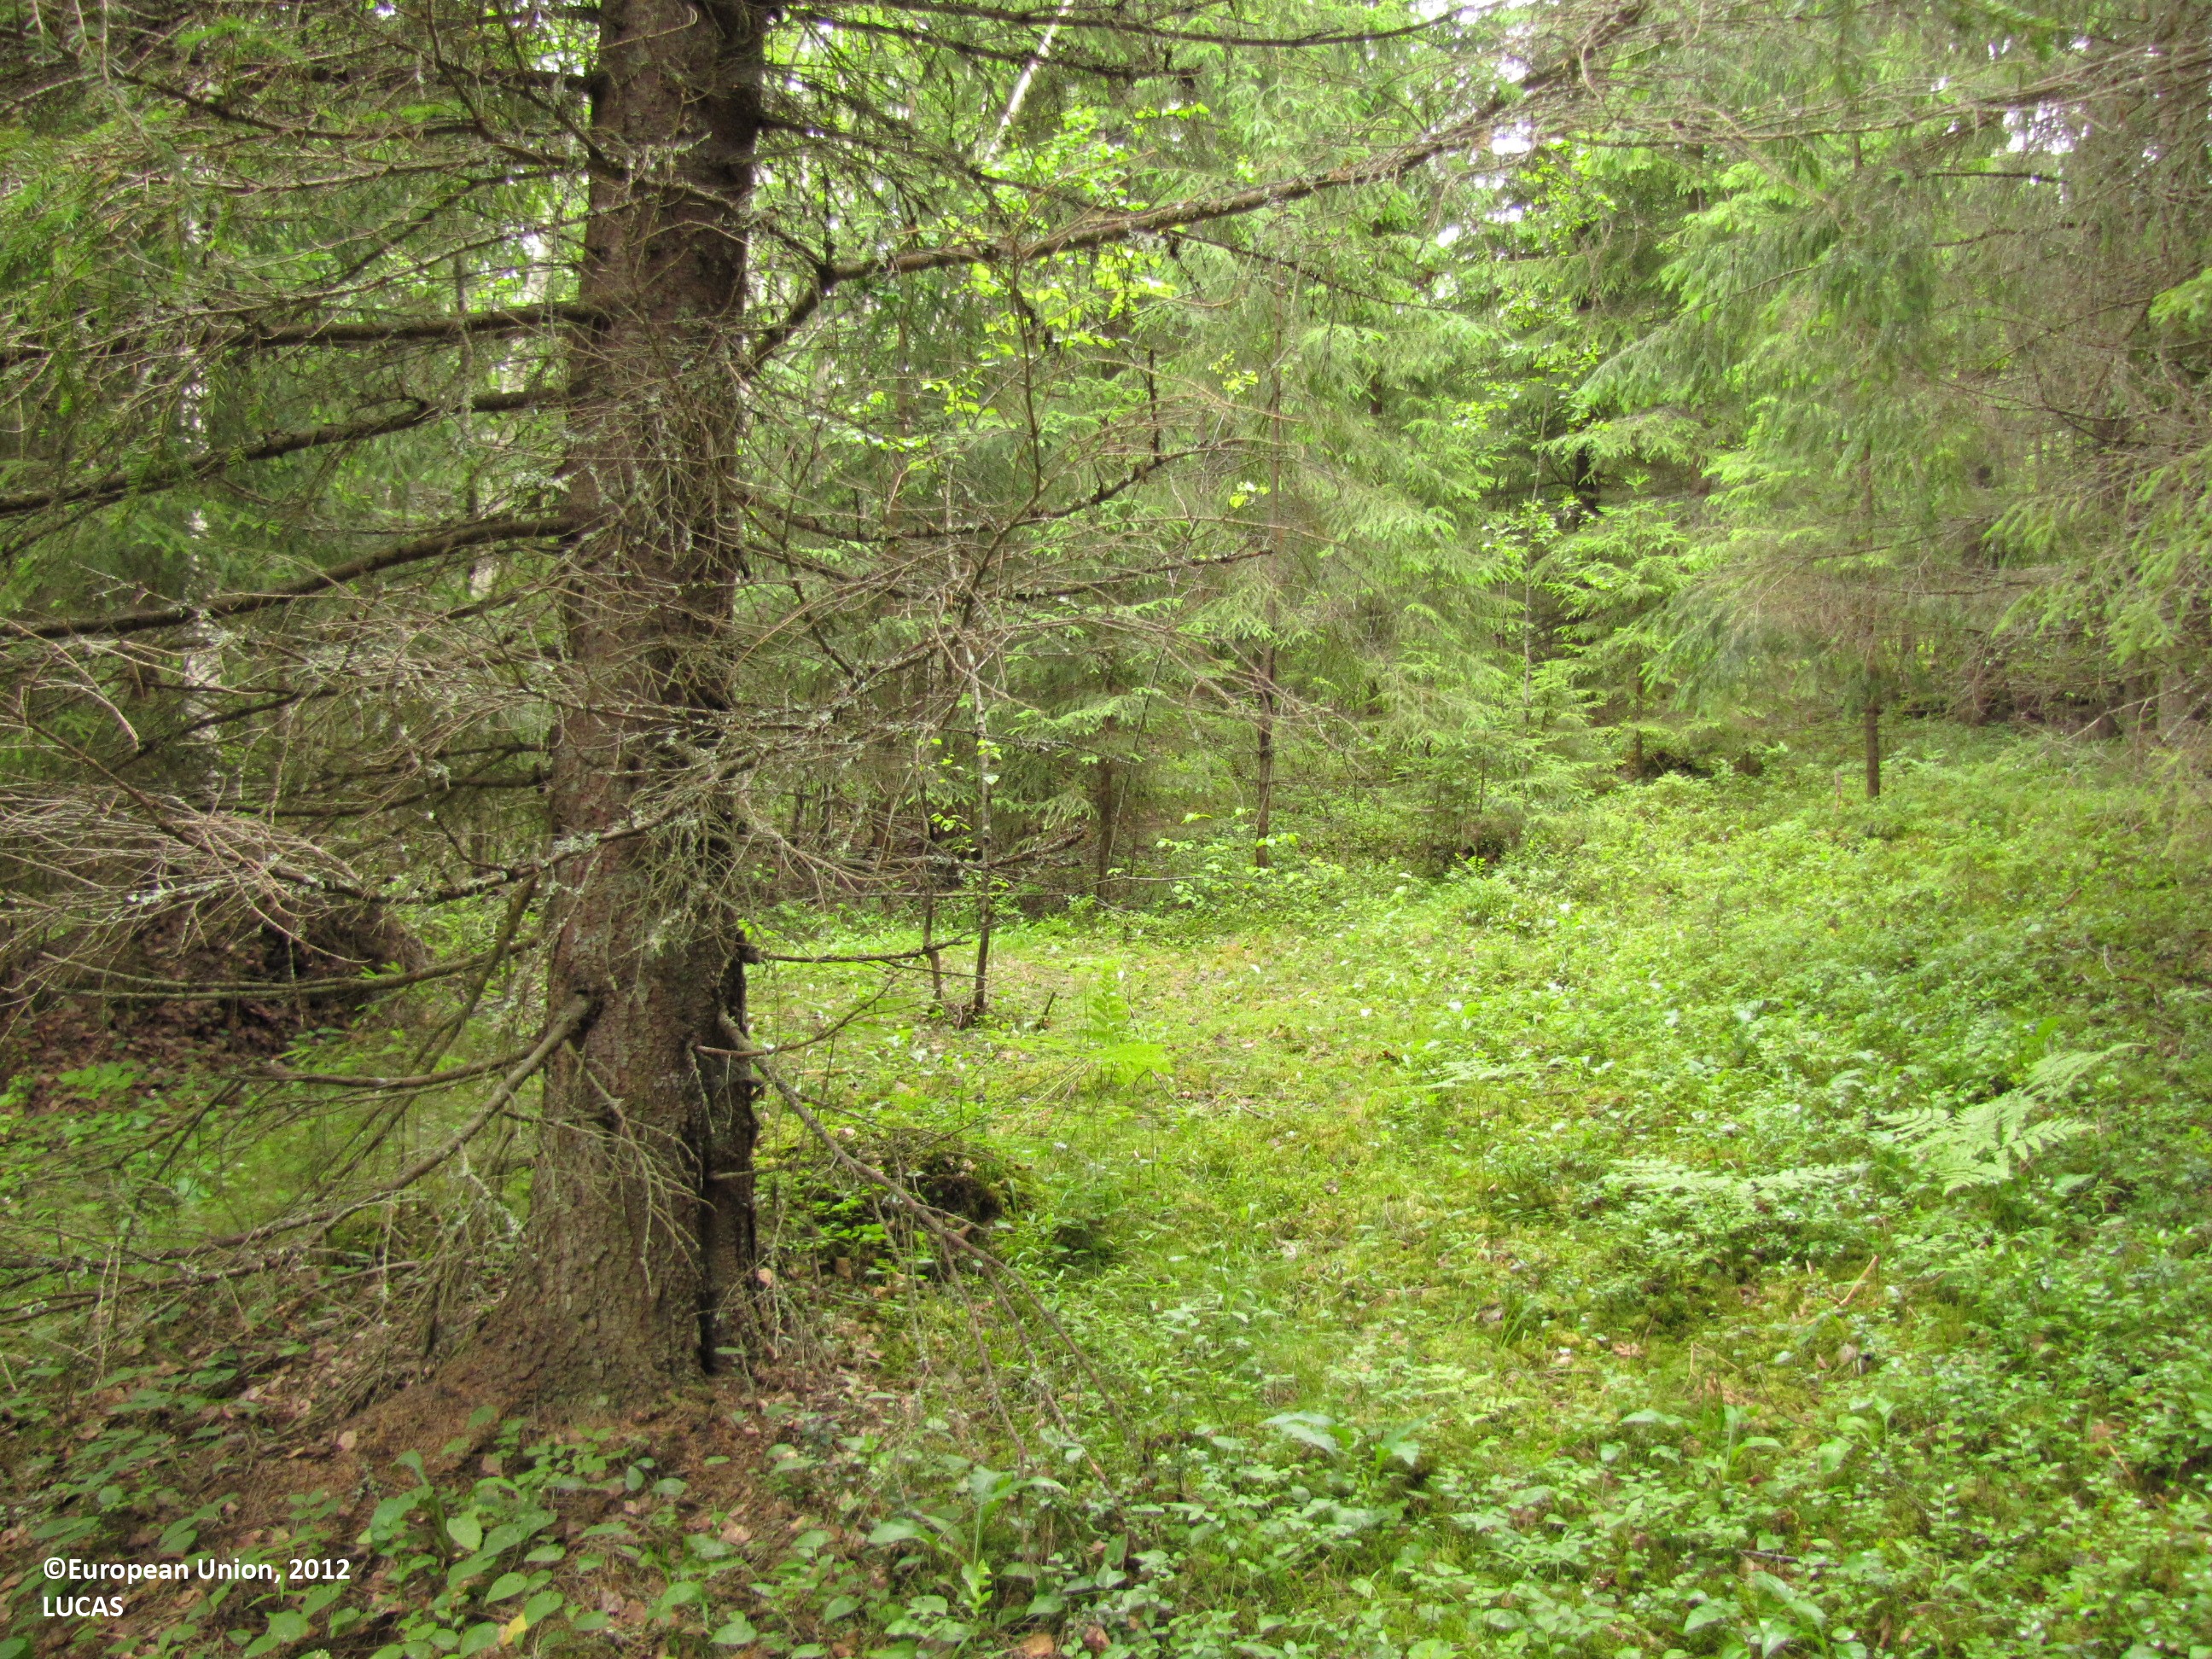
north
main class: Woodland
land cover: Spruce dominated coniferous woodland
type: boreal forest
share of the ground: > 75 %
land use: Forestry
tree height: > 5 m
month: June
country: FI
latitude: 61.7707
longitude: 24.5575
